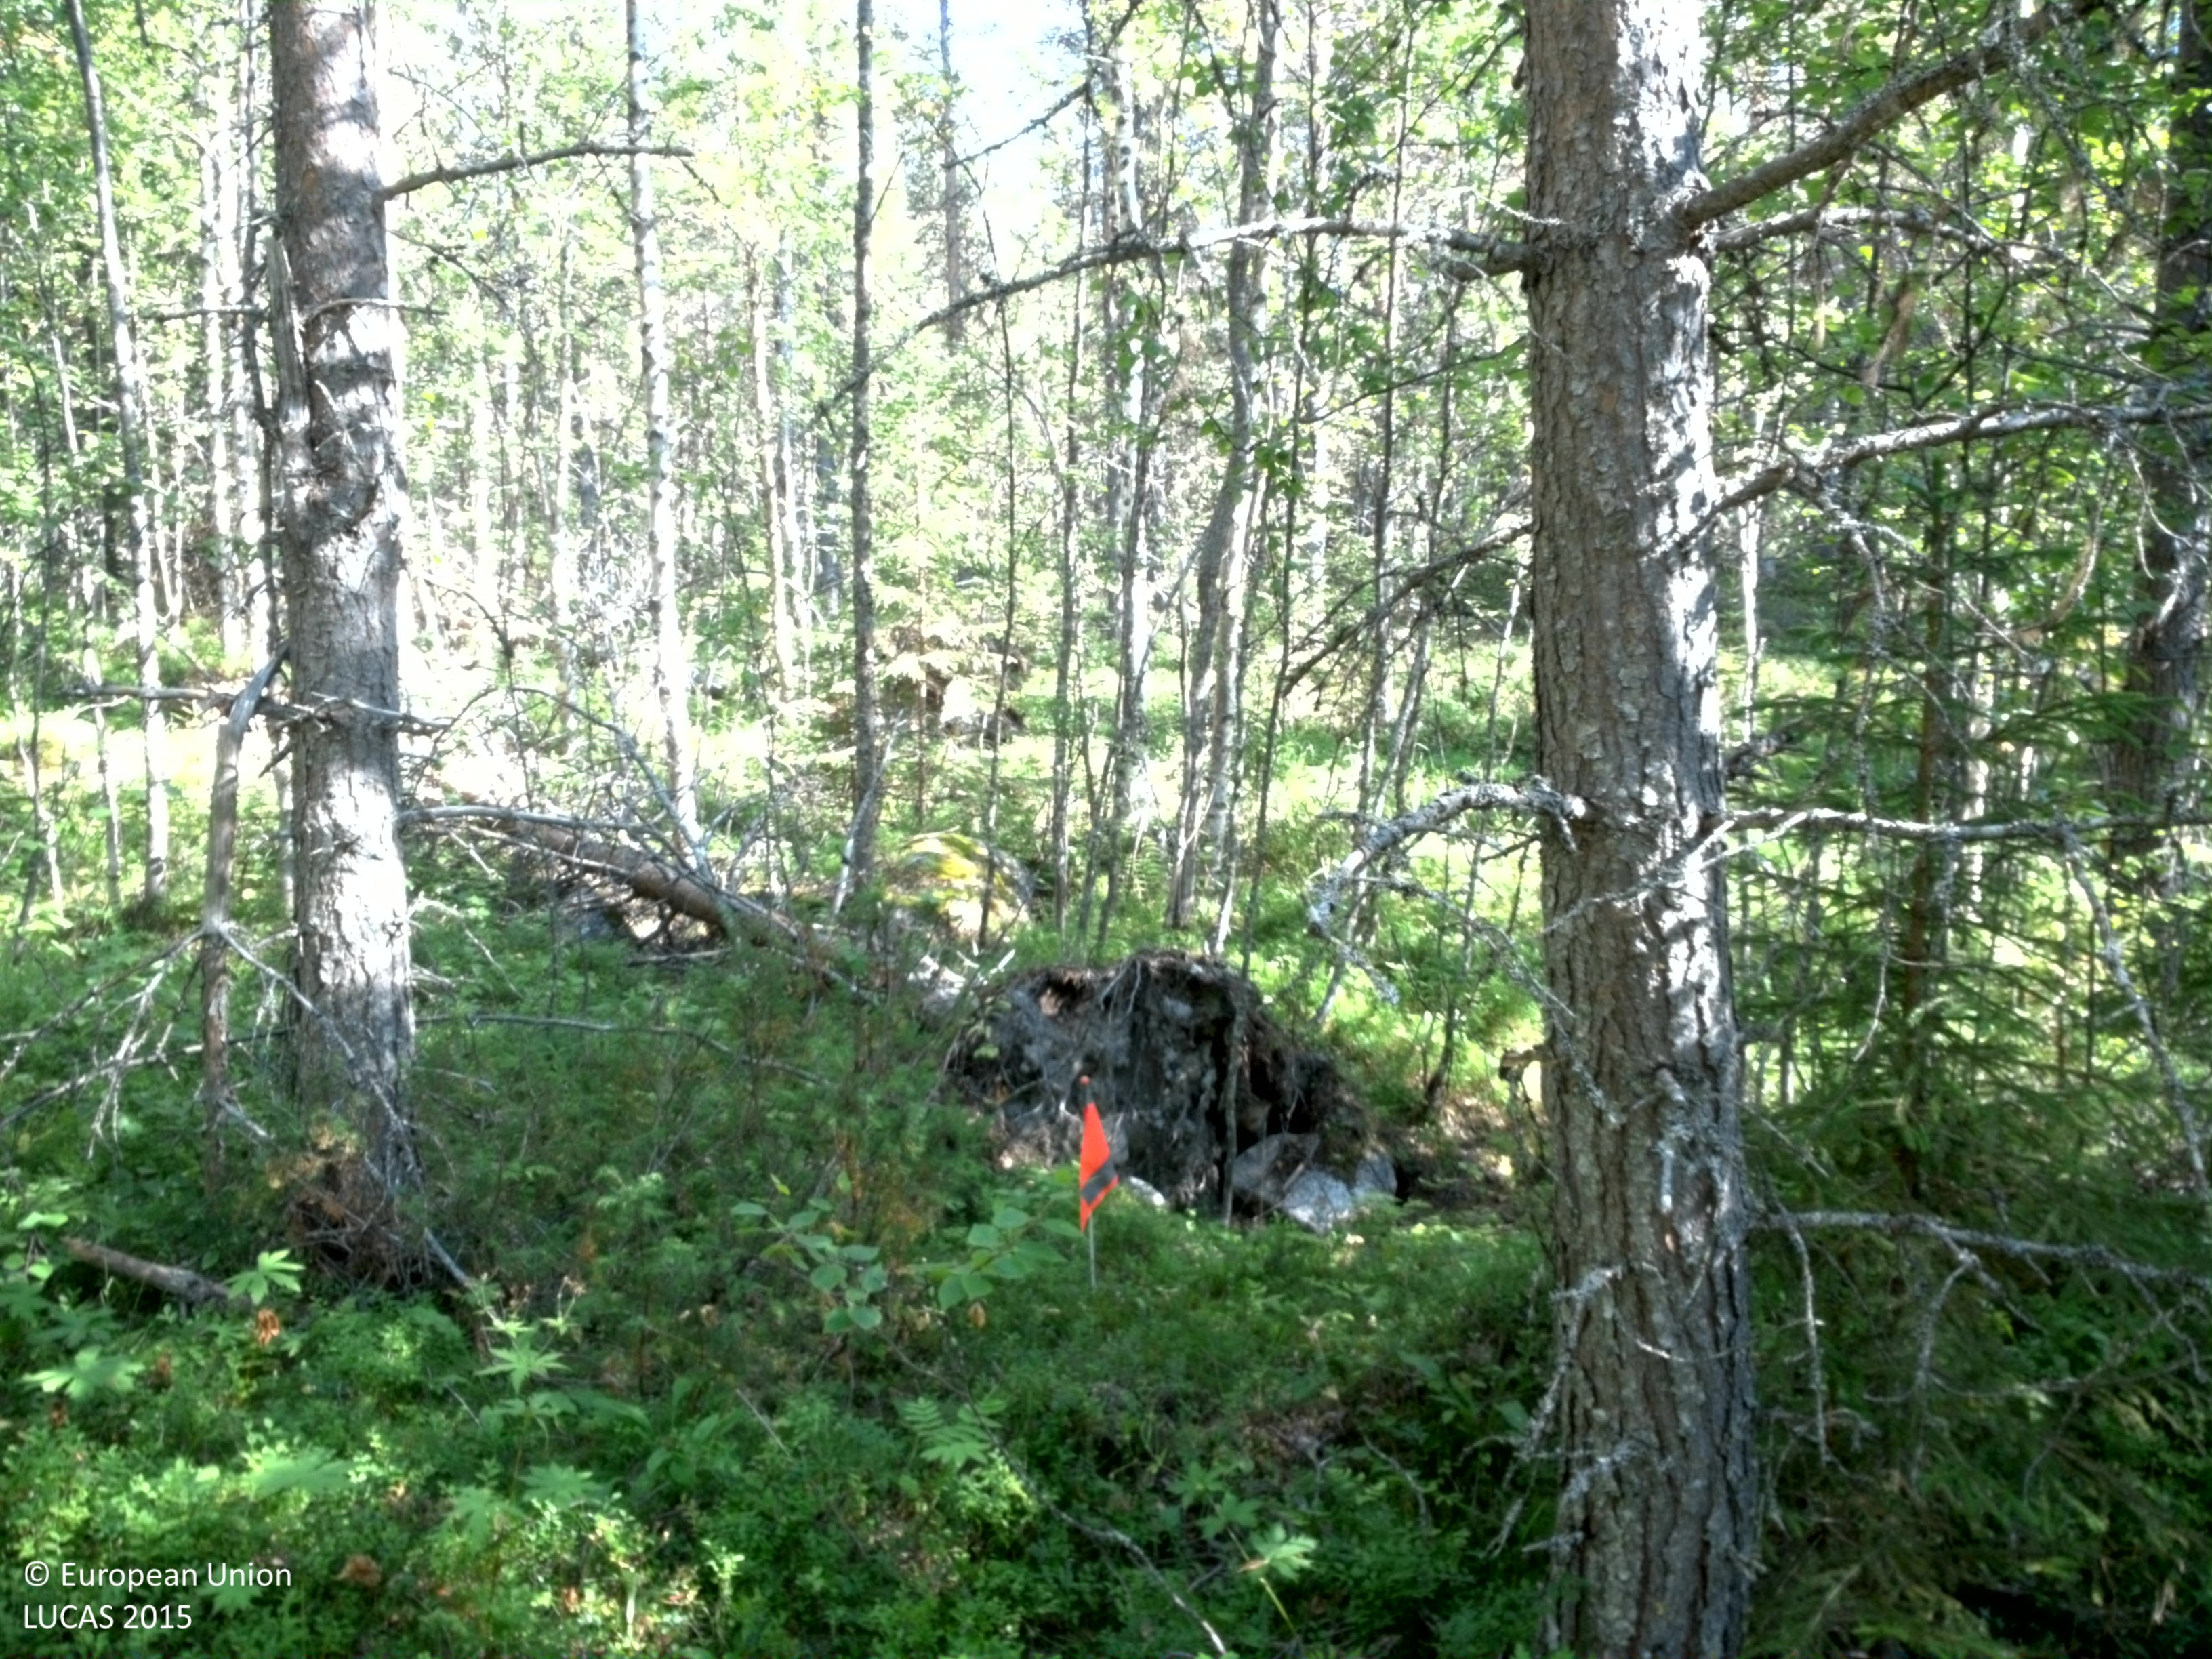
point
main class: Woodland
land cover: Pine dominated mixed woodland
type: boreal forest
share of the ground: 50 - 75 %
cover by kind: coniferous forest trees 35 %, broadleaved forest trees 30 %, shrubs 25 %, herbaceous plants 10 %
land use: Forestry
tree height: > 5 m
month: August
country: SE
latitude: 64.6740
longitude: 16.6920
